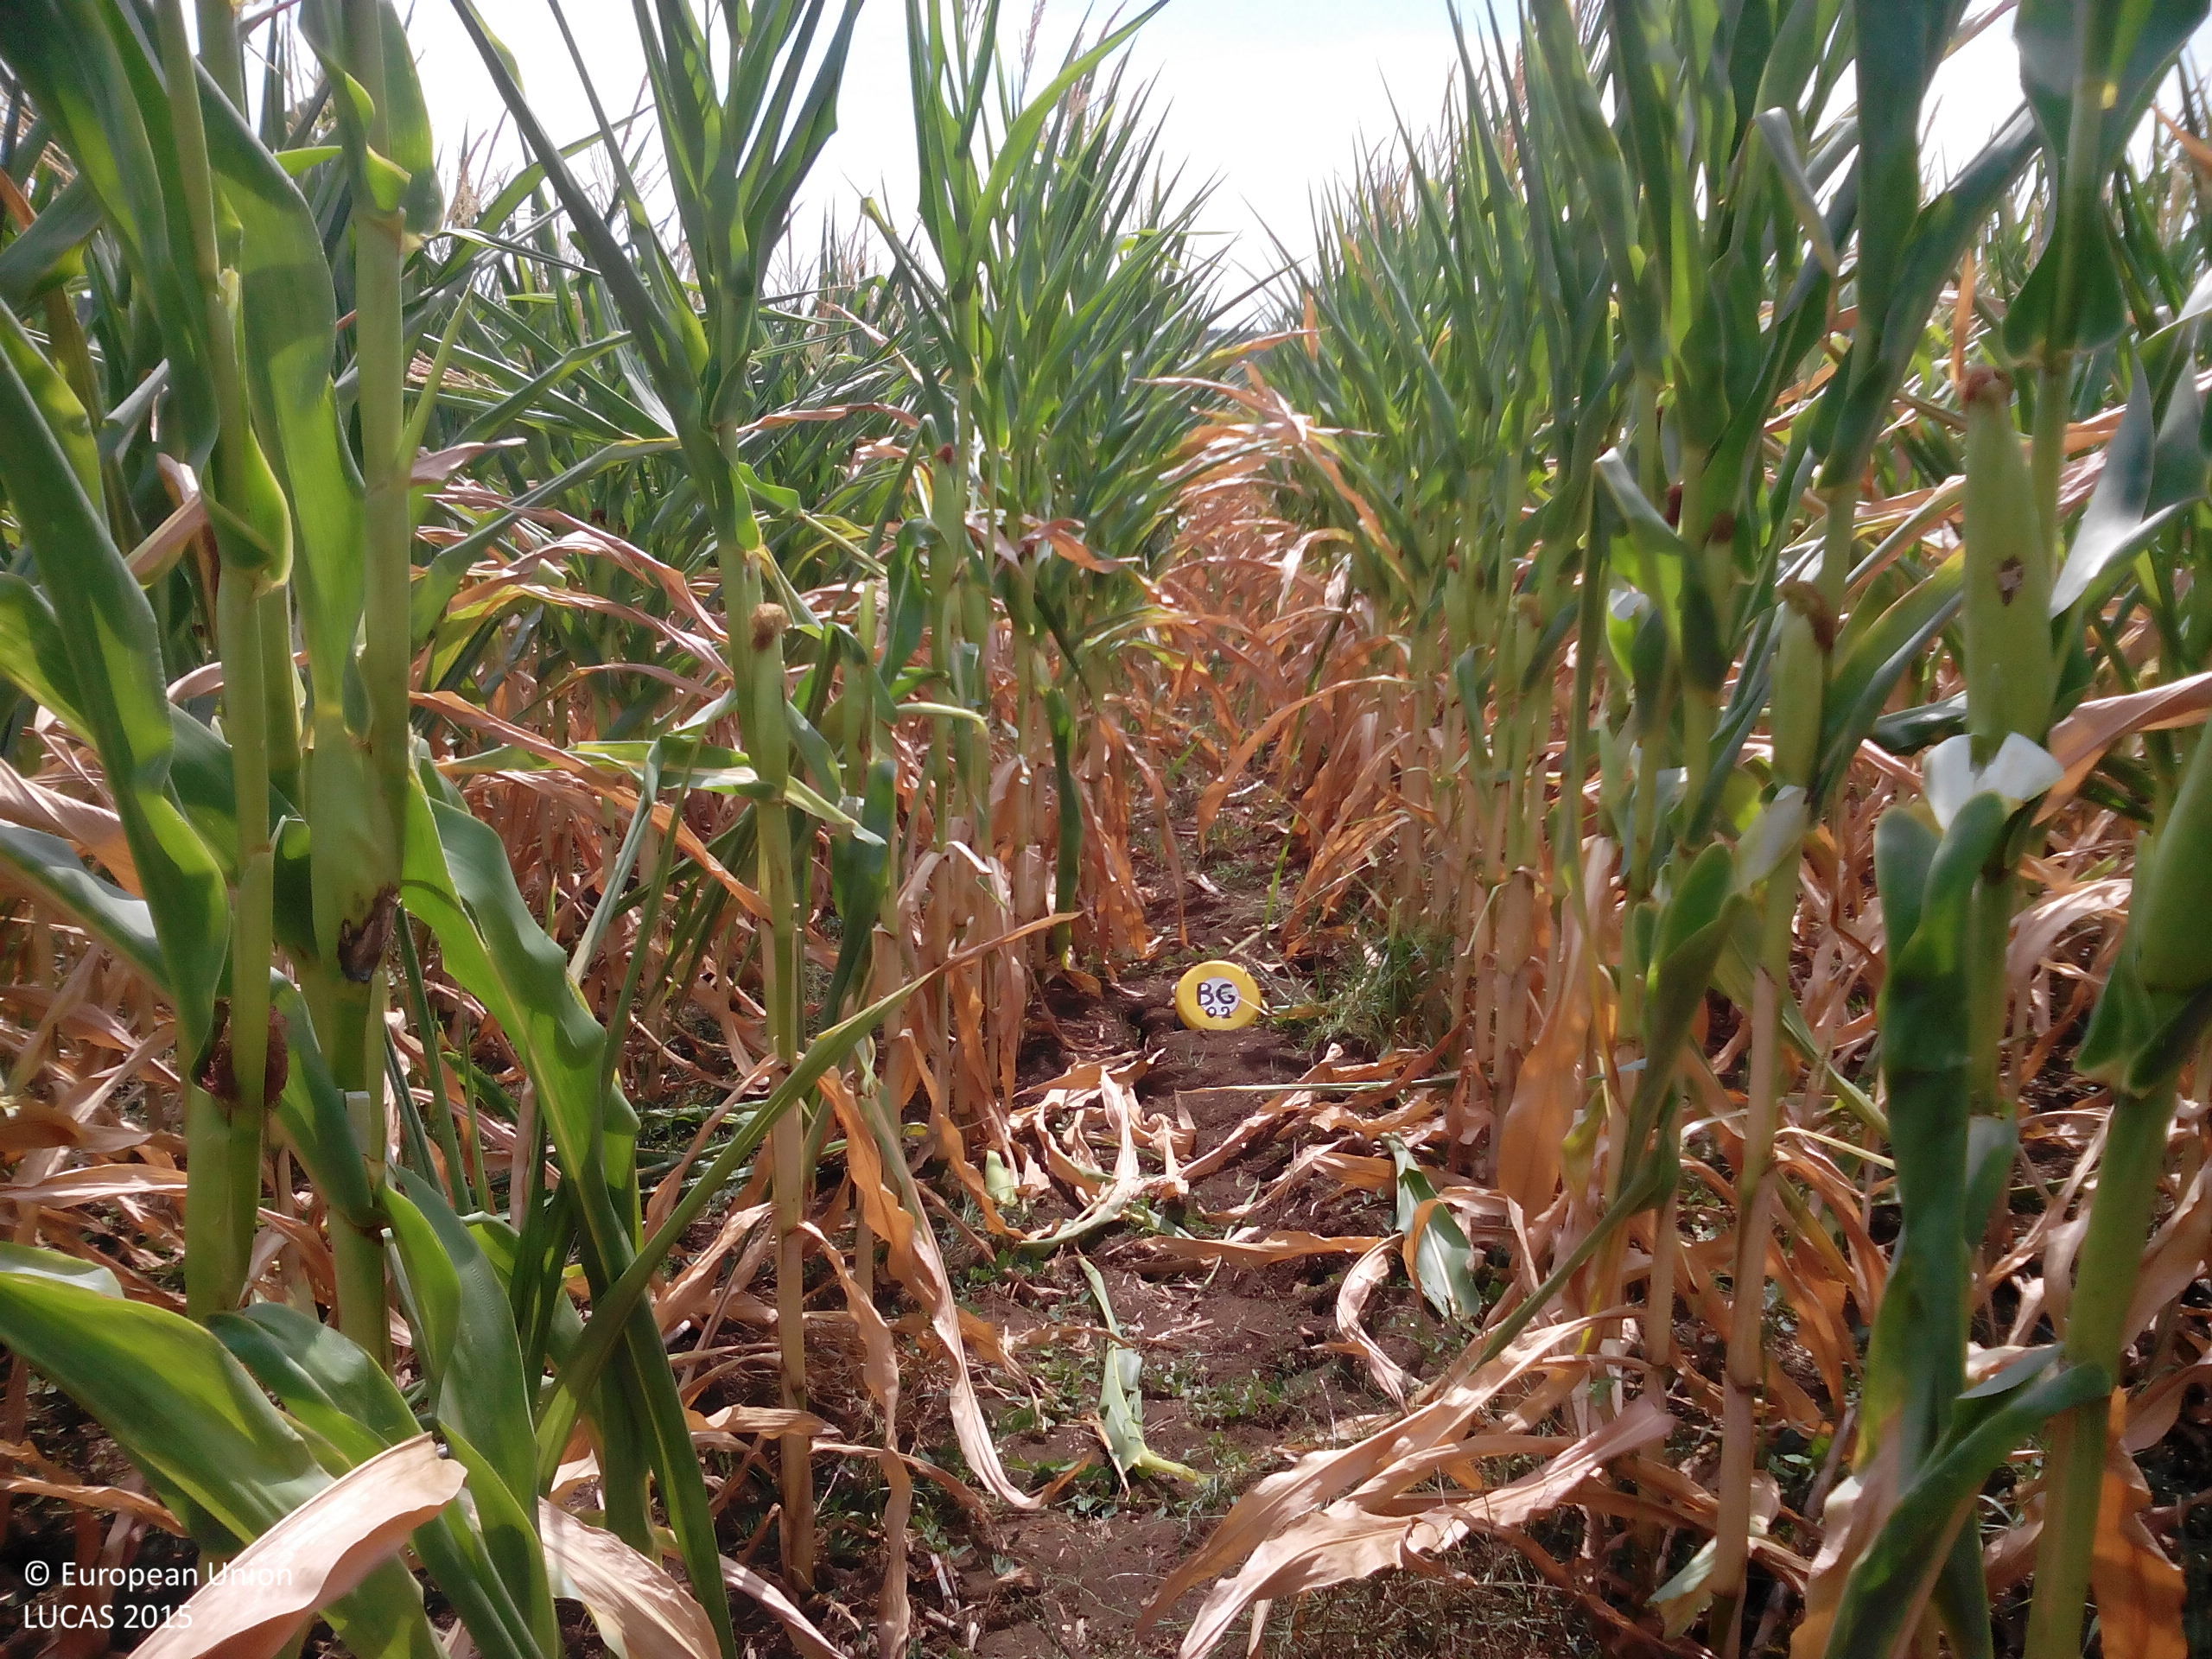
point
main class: Cropland
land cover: Maize
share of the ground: > 75 %
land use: Agriculture (excluding fallow land and kitchen gardens)
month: August
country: BG
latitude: 43.1661
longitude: 23.8100
